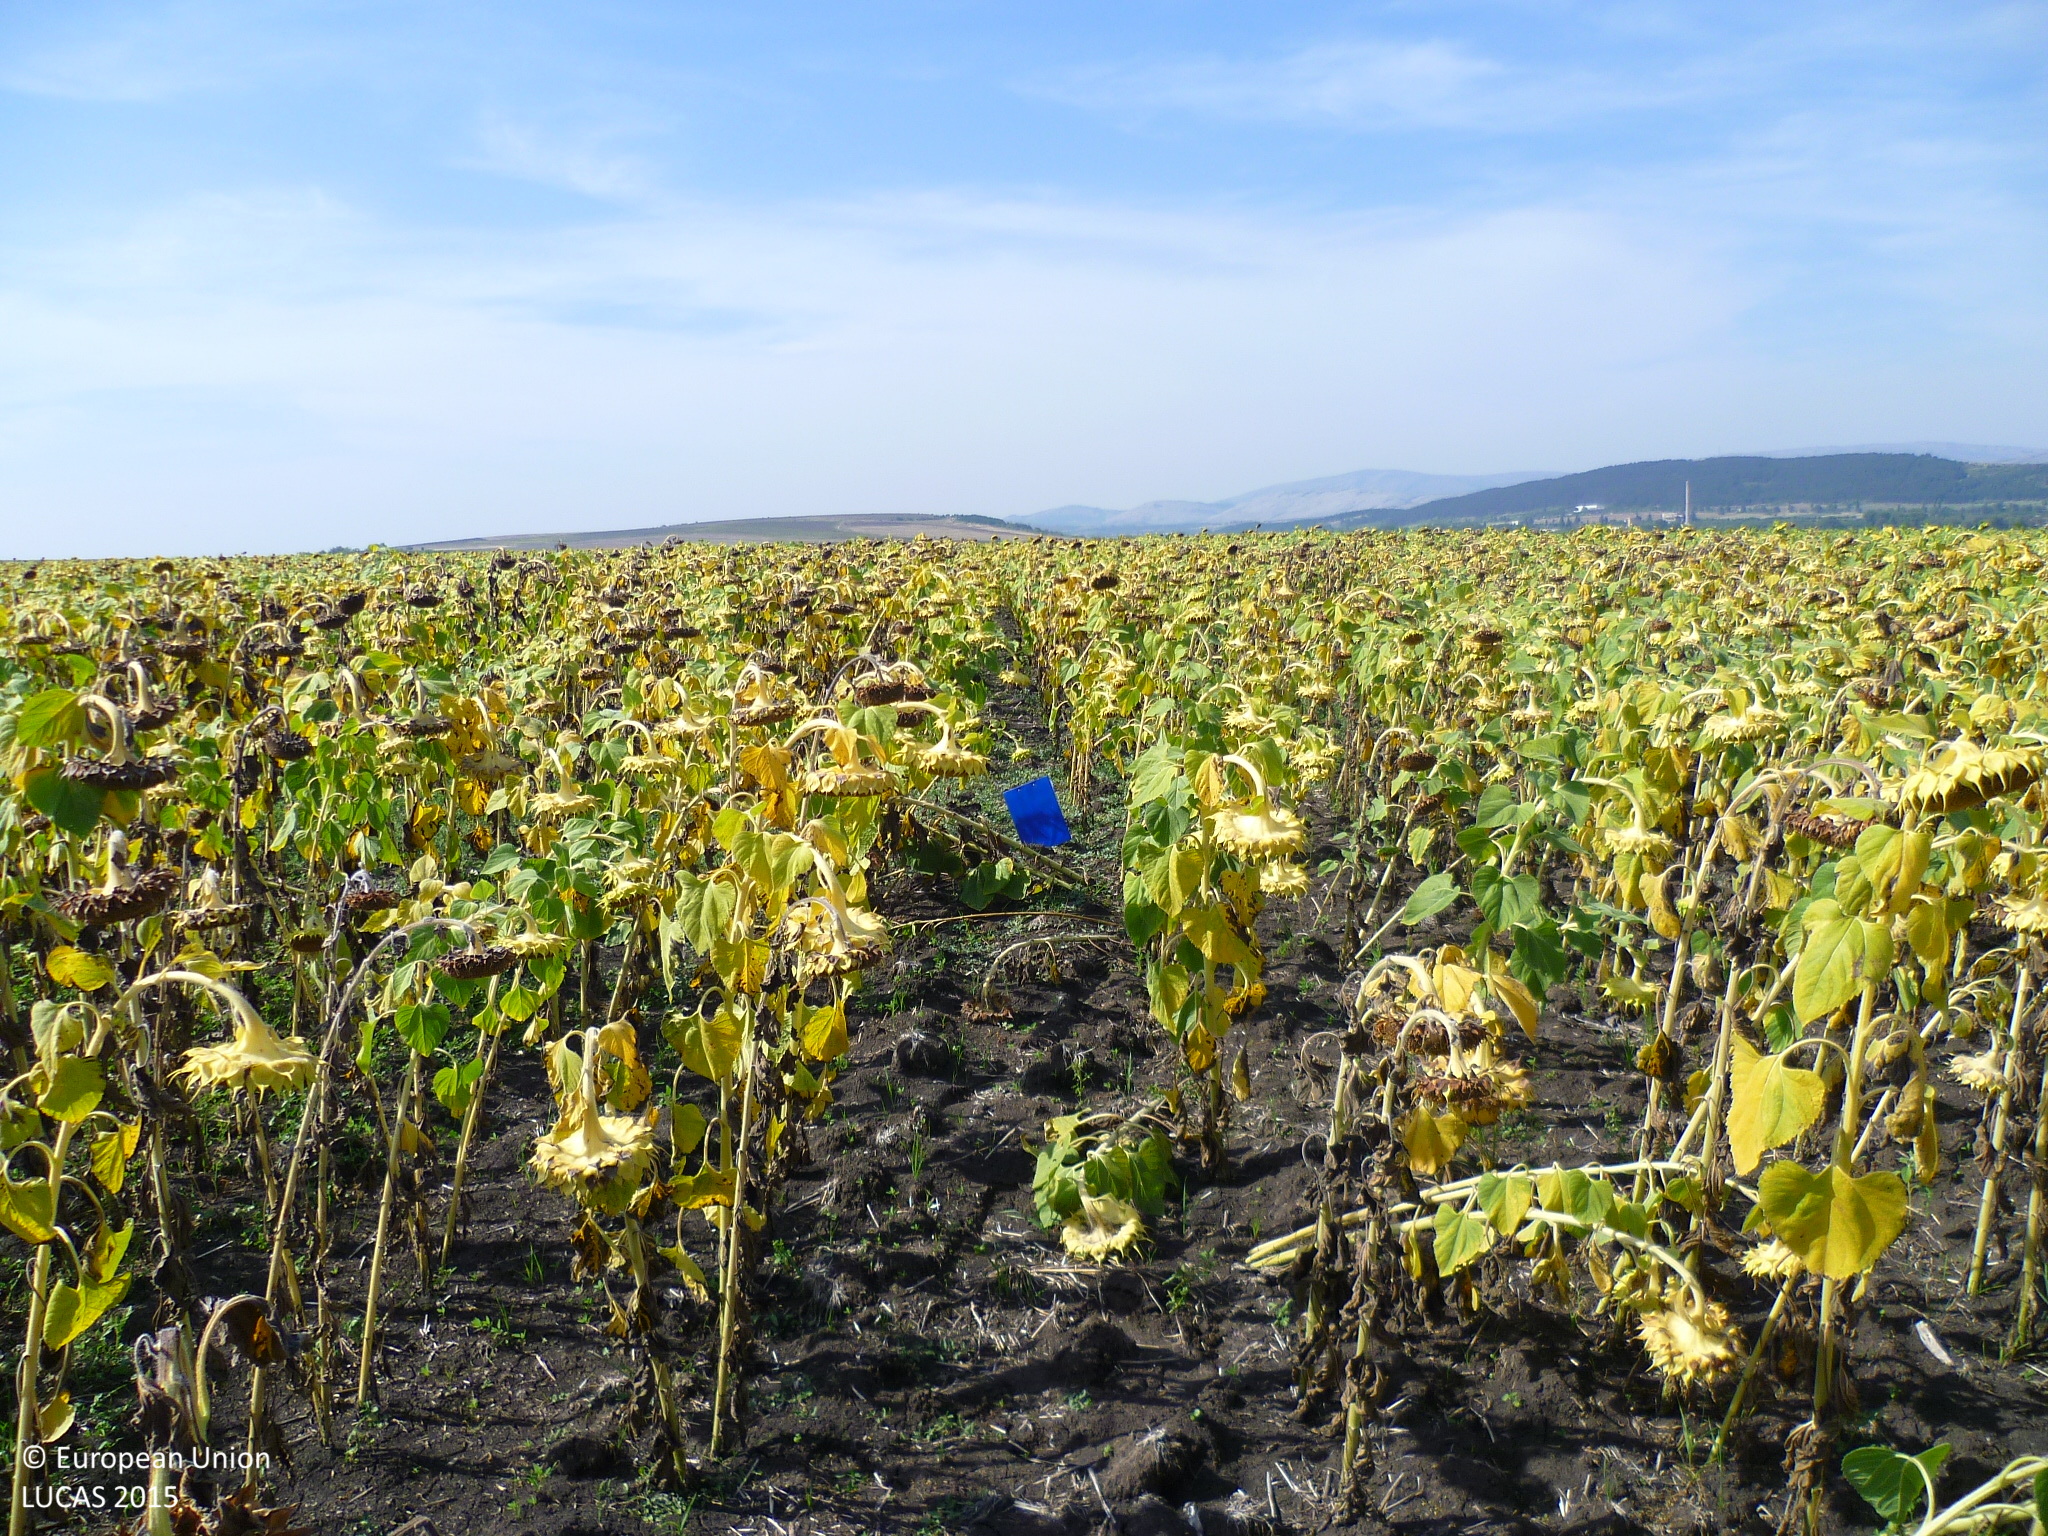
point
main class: Cropland
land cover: Sunflower
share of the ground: > 75 %
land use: Agriculture (excluding fallow land and kitchen gardens)
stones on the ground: < 10 %
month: December
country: BG
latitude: 42.8243
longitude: 23.0836
